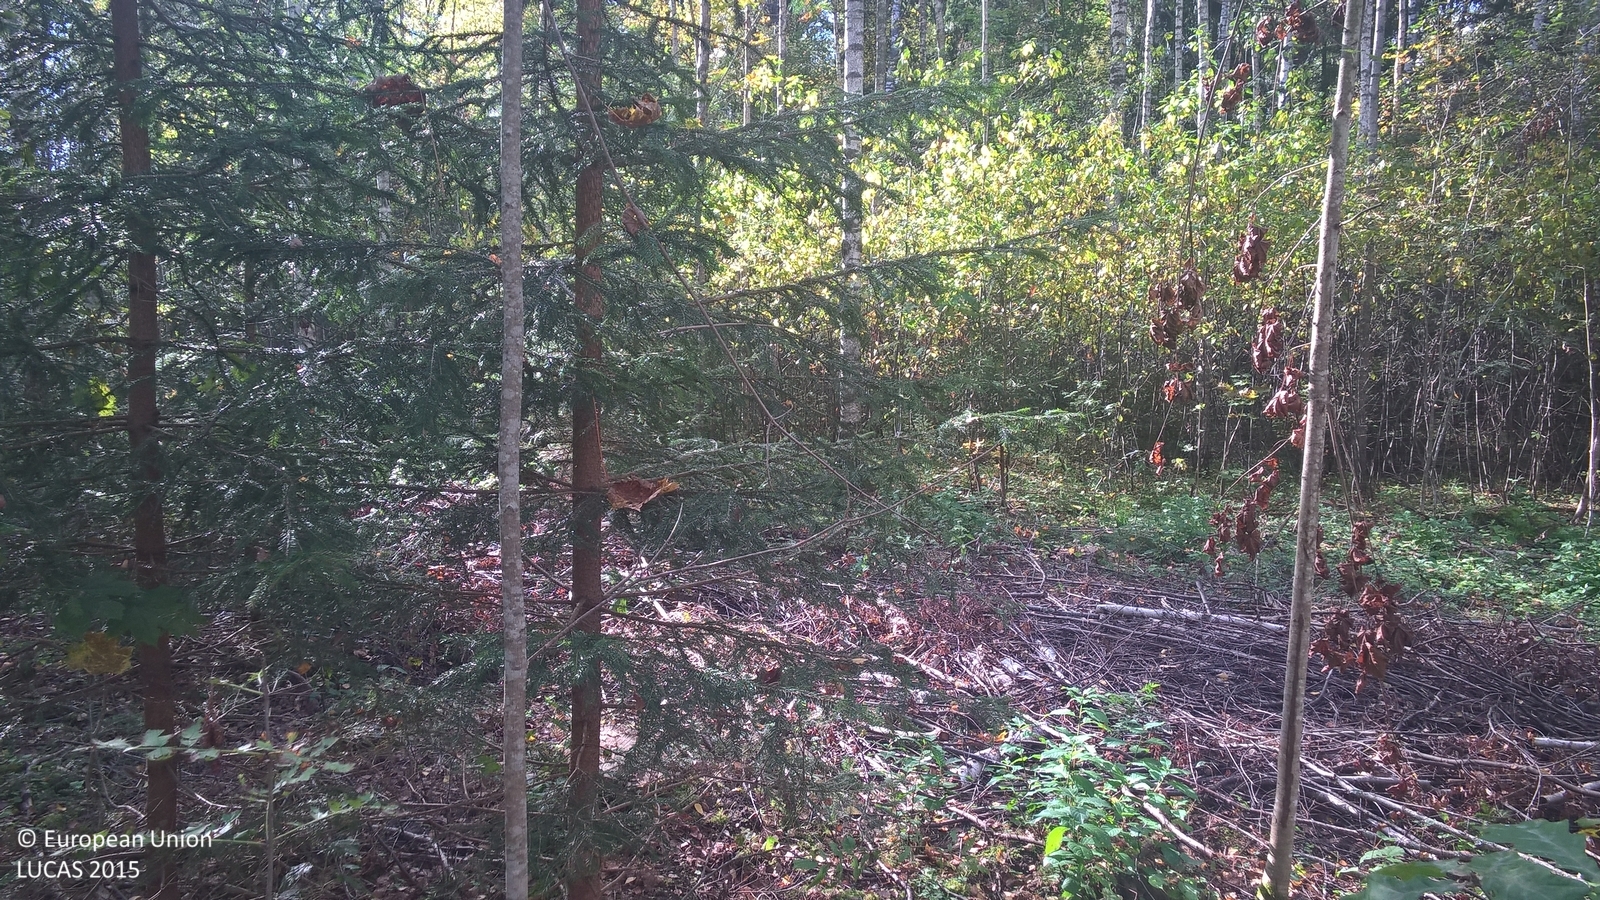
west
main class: Woodland
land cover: Spruce dominated mixed woodland
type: hemiboreal forest and nemoral coniferous forest and mixed broadleaved-coniferous forest
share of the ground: > 75 %
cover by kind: coniferous forest trees 40 %, broadleaved forest trees 40 %, herbaceous plants 10 %, lichens and mosses 10 %
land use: Forestry
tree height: > 5 m
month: September
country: LV
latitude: 57.7989
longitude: 25.5775
